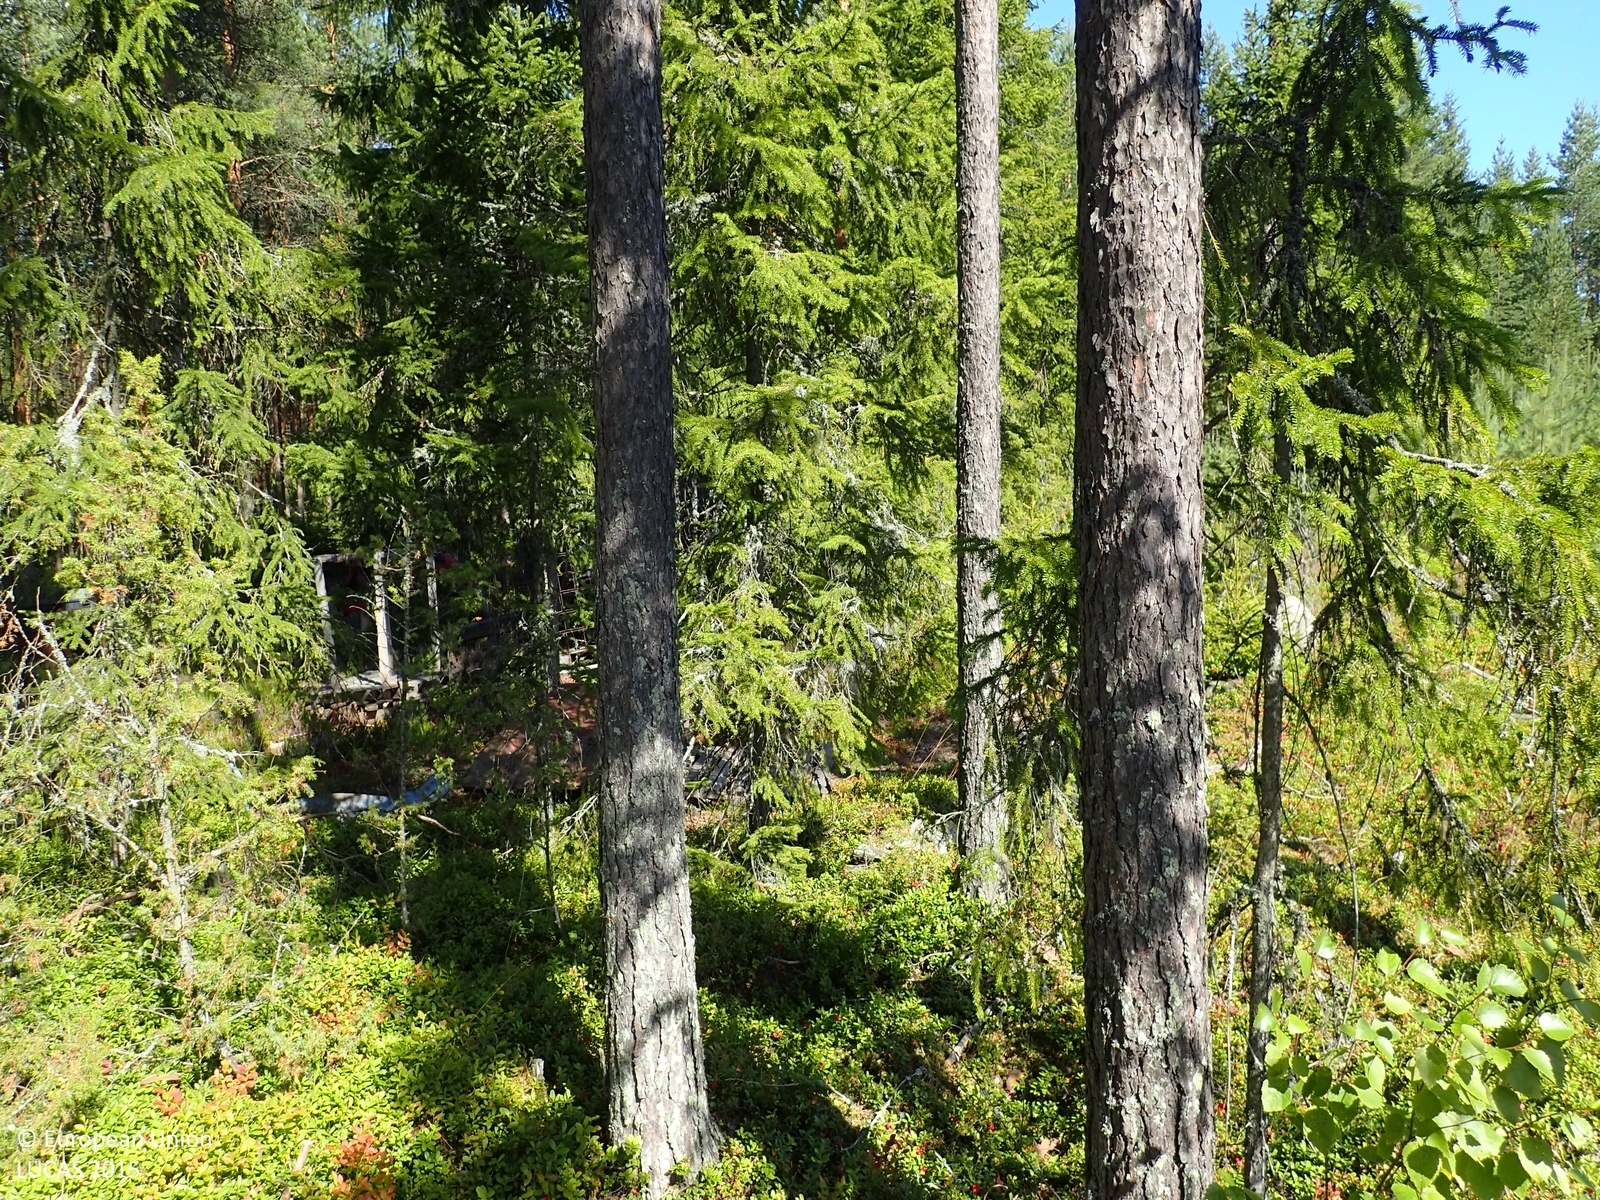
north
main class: Woodland
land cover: Pine dominated coniferous woodland
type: boreal forest
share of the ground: 50 - 75 %
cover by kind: coniferous forest trees 60 %, shrubs 40 %
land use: Forestry
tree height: > 5 m
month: August
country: FI
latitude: 62.4901
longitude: 22.2983
